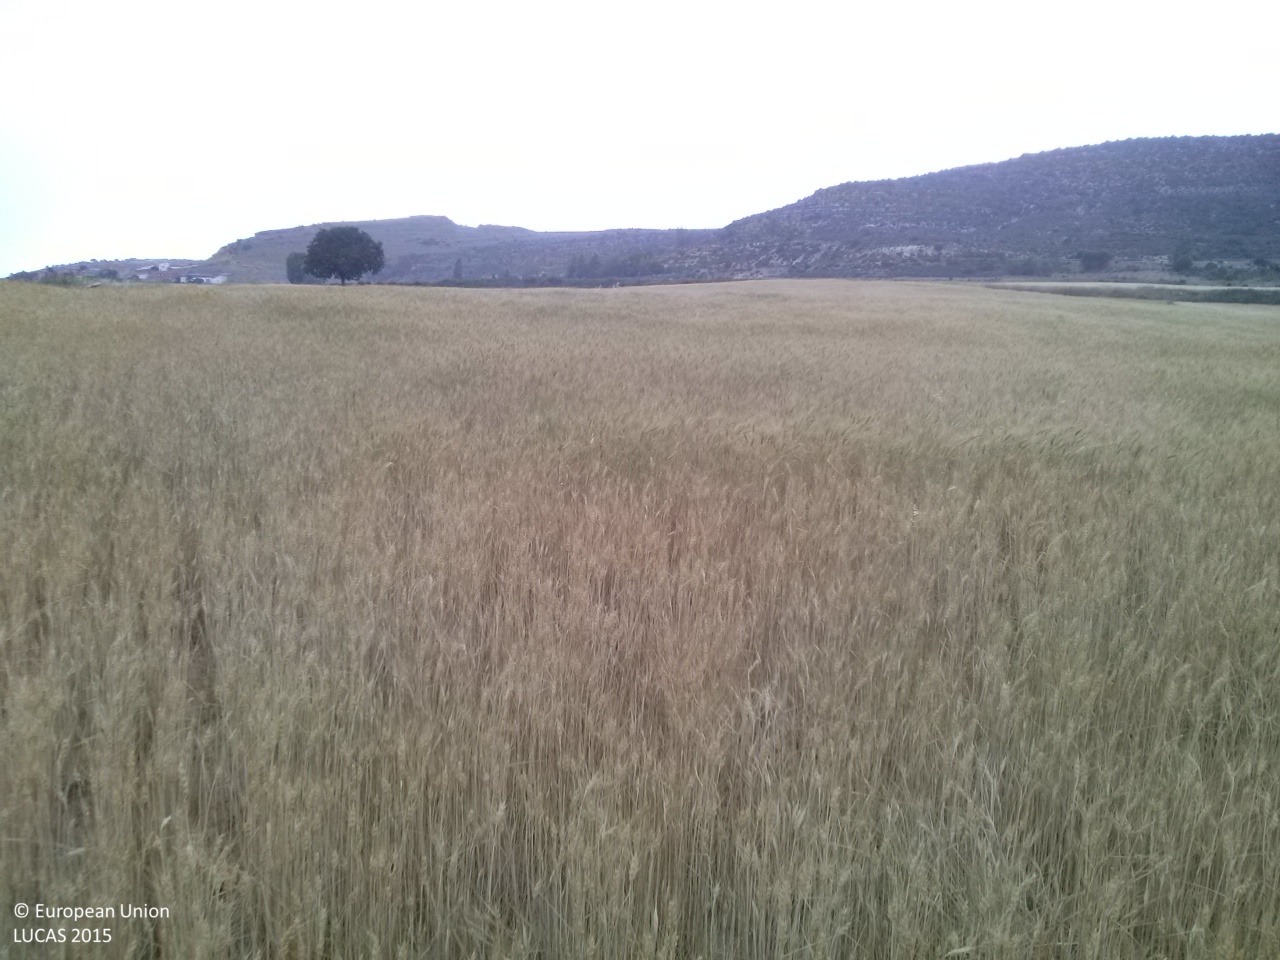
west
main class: Cropland
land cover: Barley
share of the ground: > 75 %
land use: Agriculture (excluding fallow land and kitchen gardens)
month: June
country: ES
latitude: 39.9104
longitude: -1.8616
